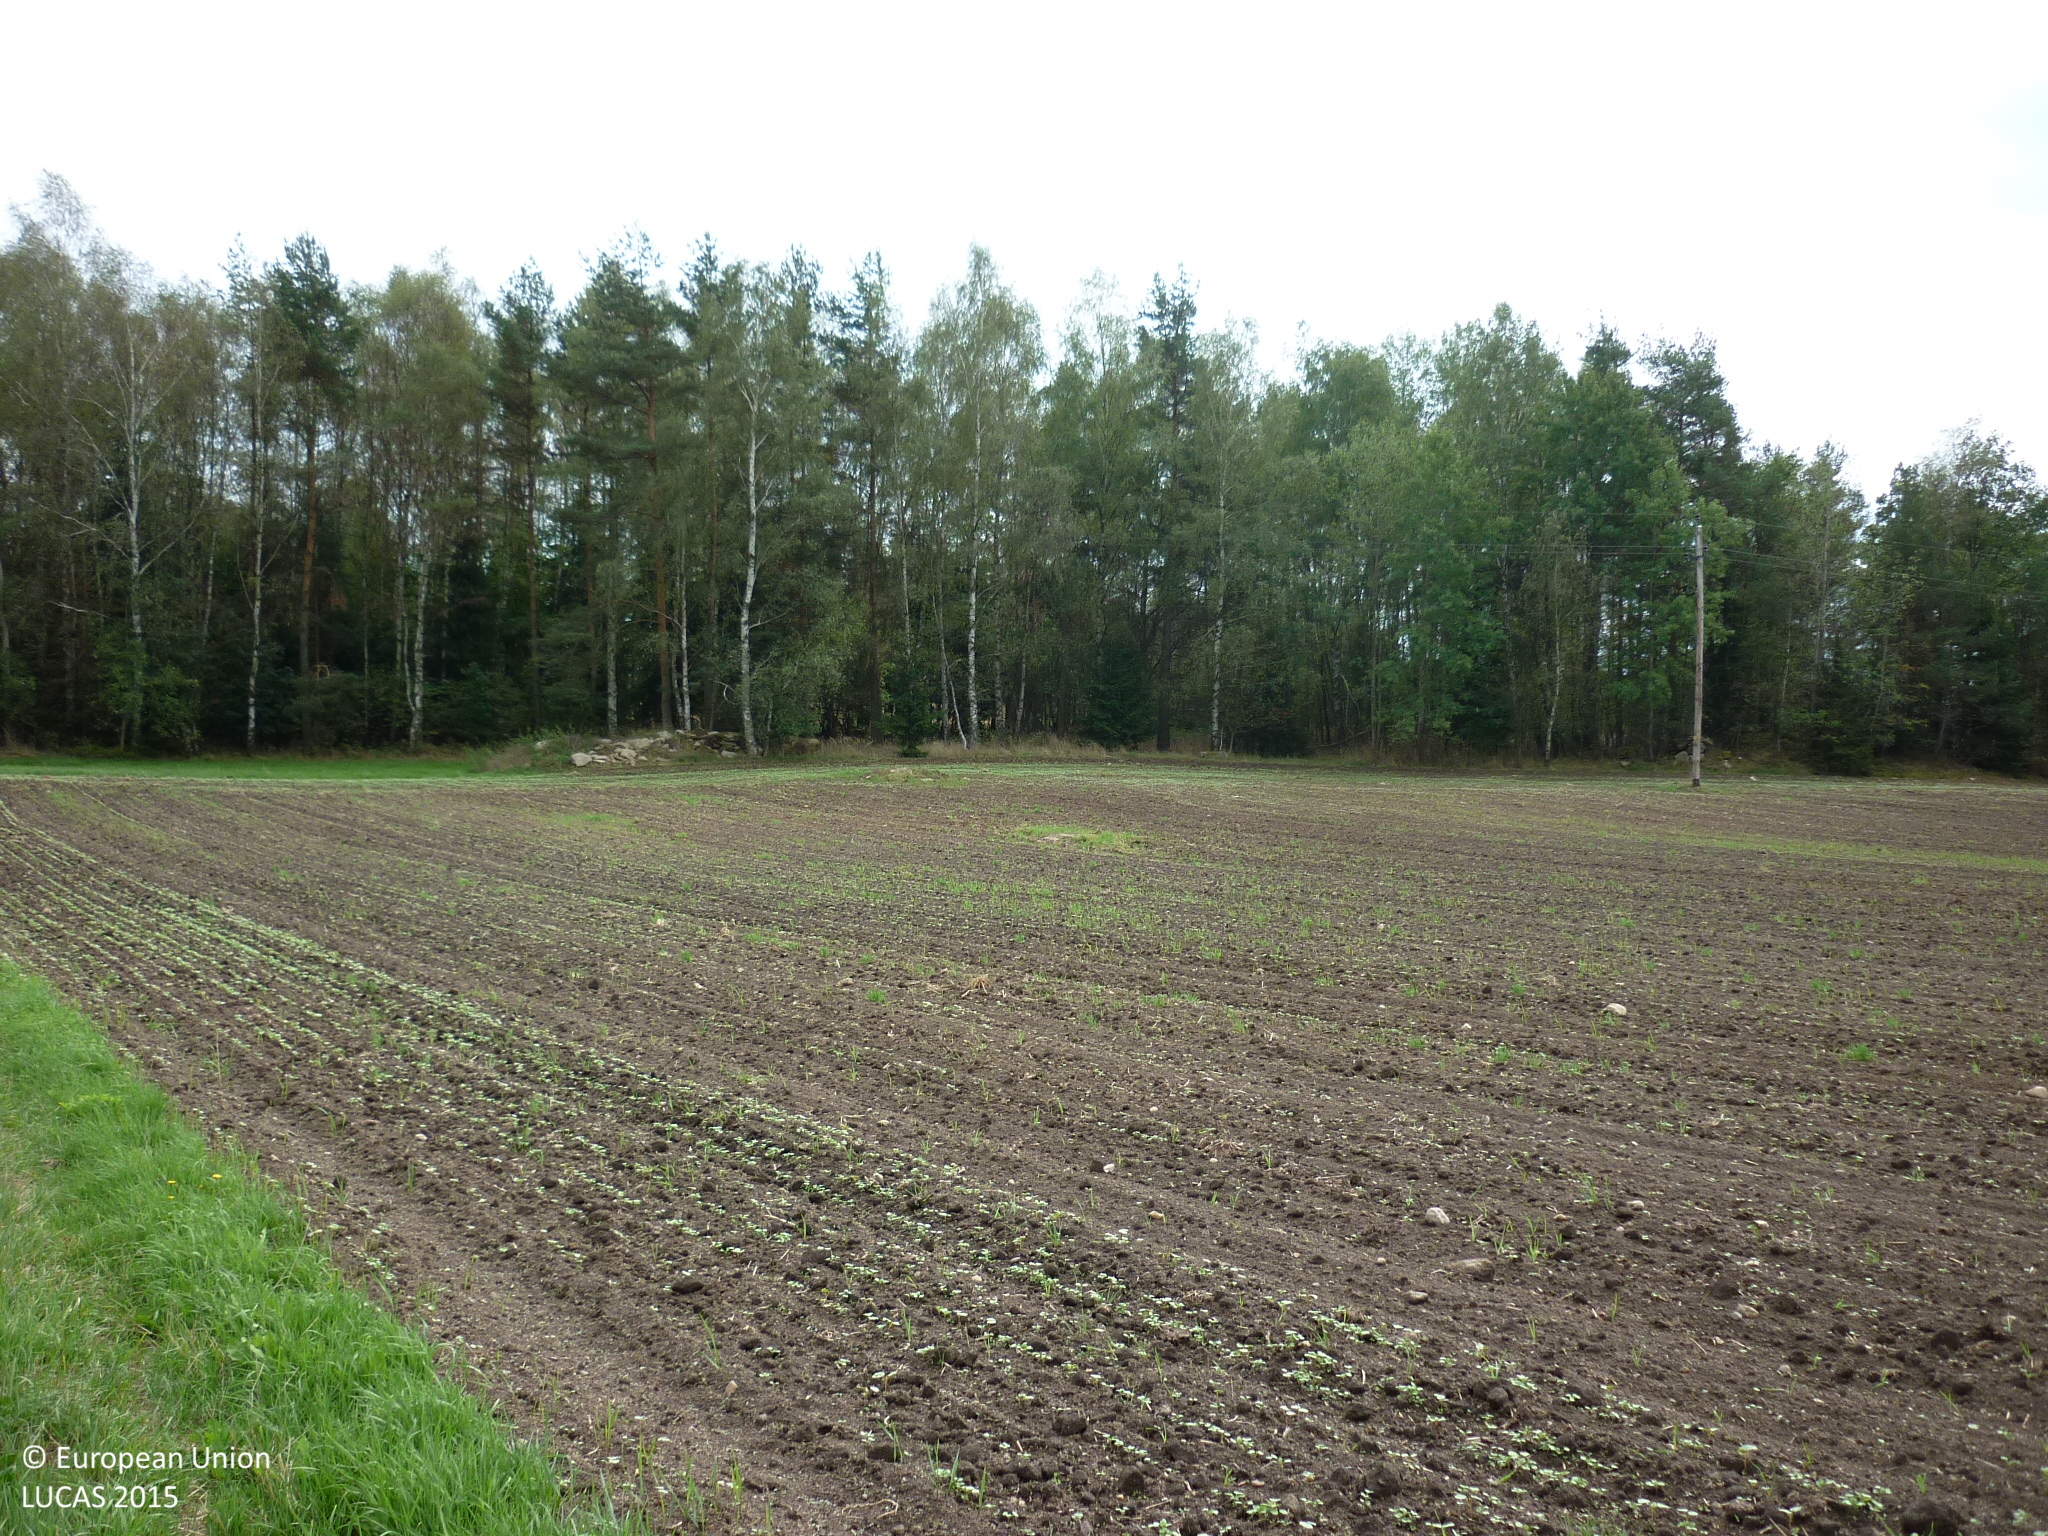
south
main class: Grassland
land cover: Spontaneously vegetated surfaces
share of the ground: 50 - 75 %
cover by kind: herbaceous plants 65 %, unconsolidated bare surface 35 %
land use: Agriculture (excluding fallow land and kitchen gardens)
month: September
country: AT
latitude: 48.8454
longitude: 15.0849
